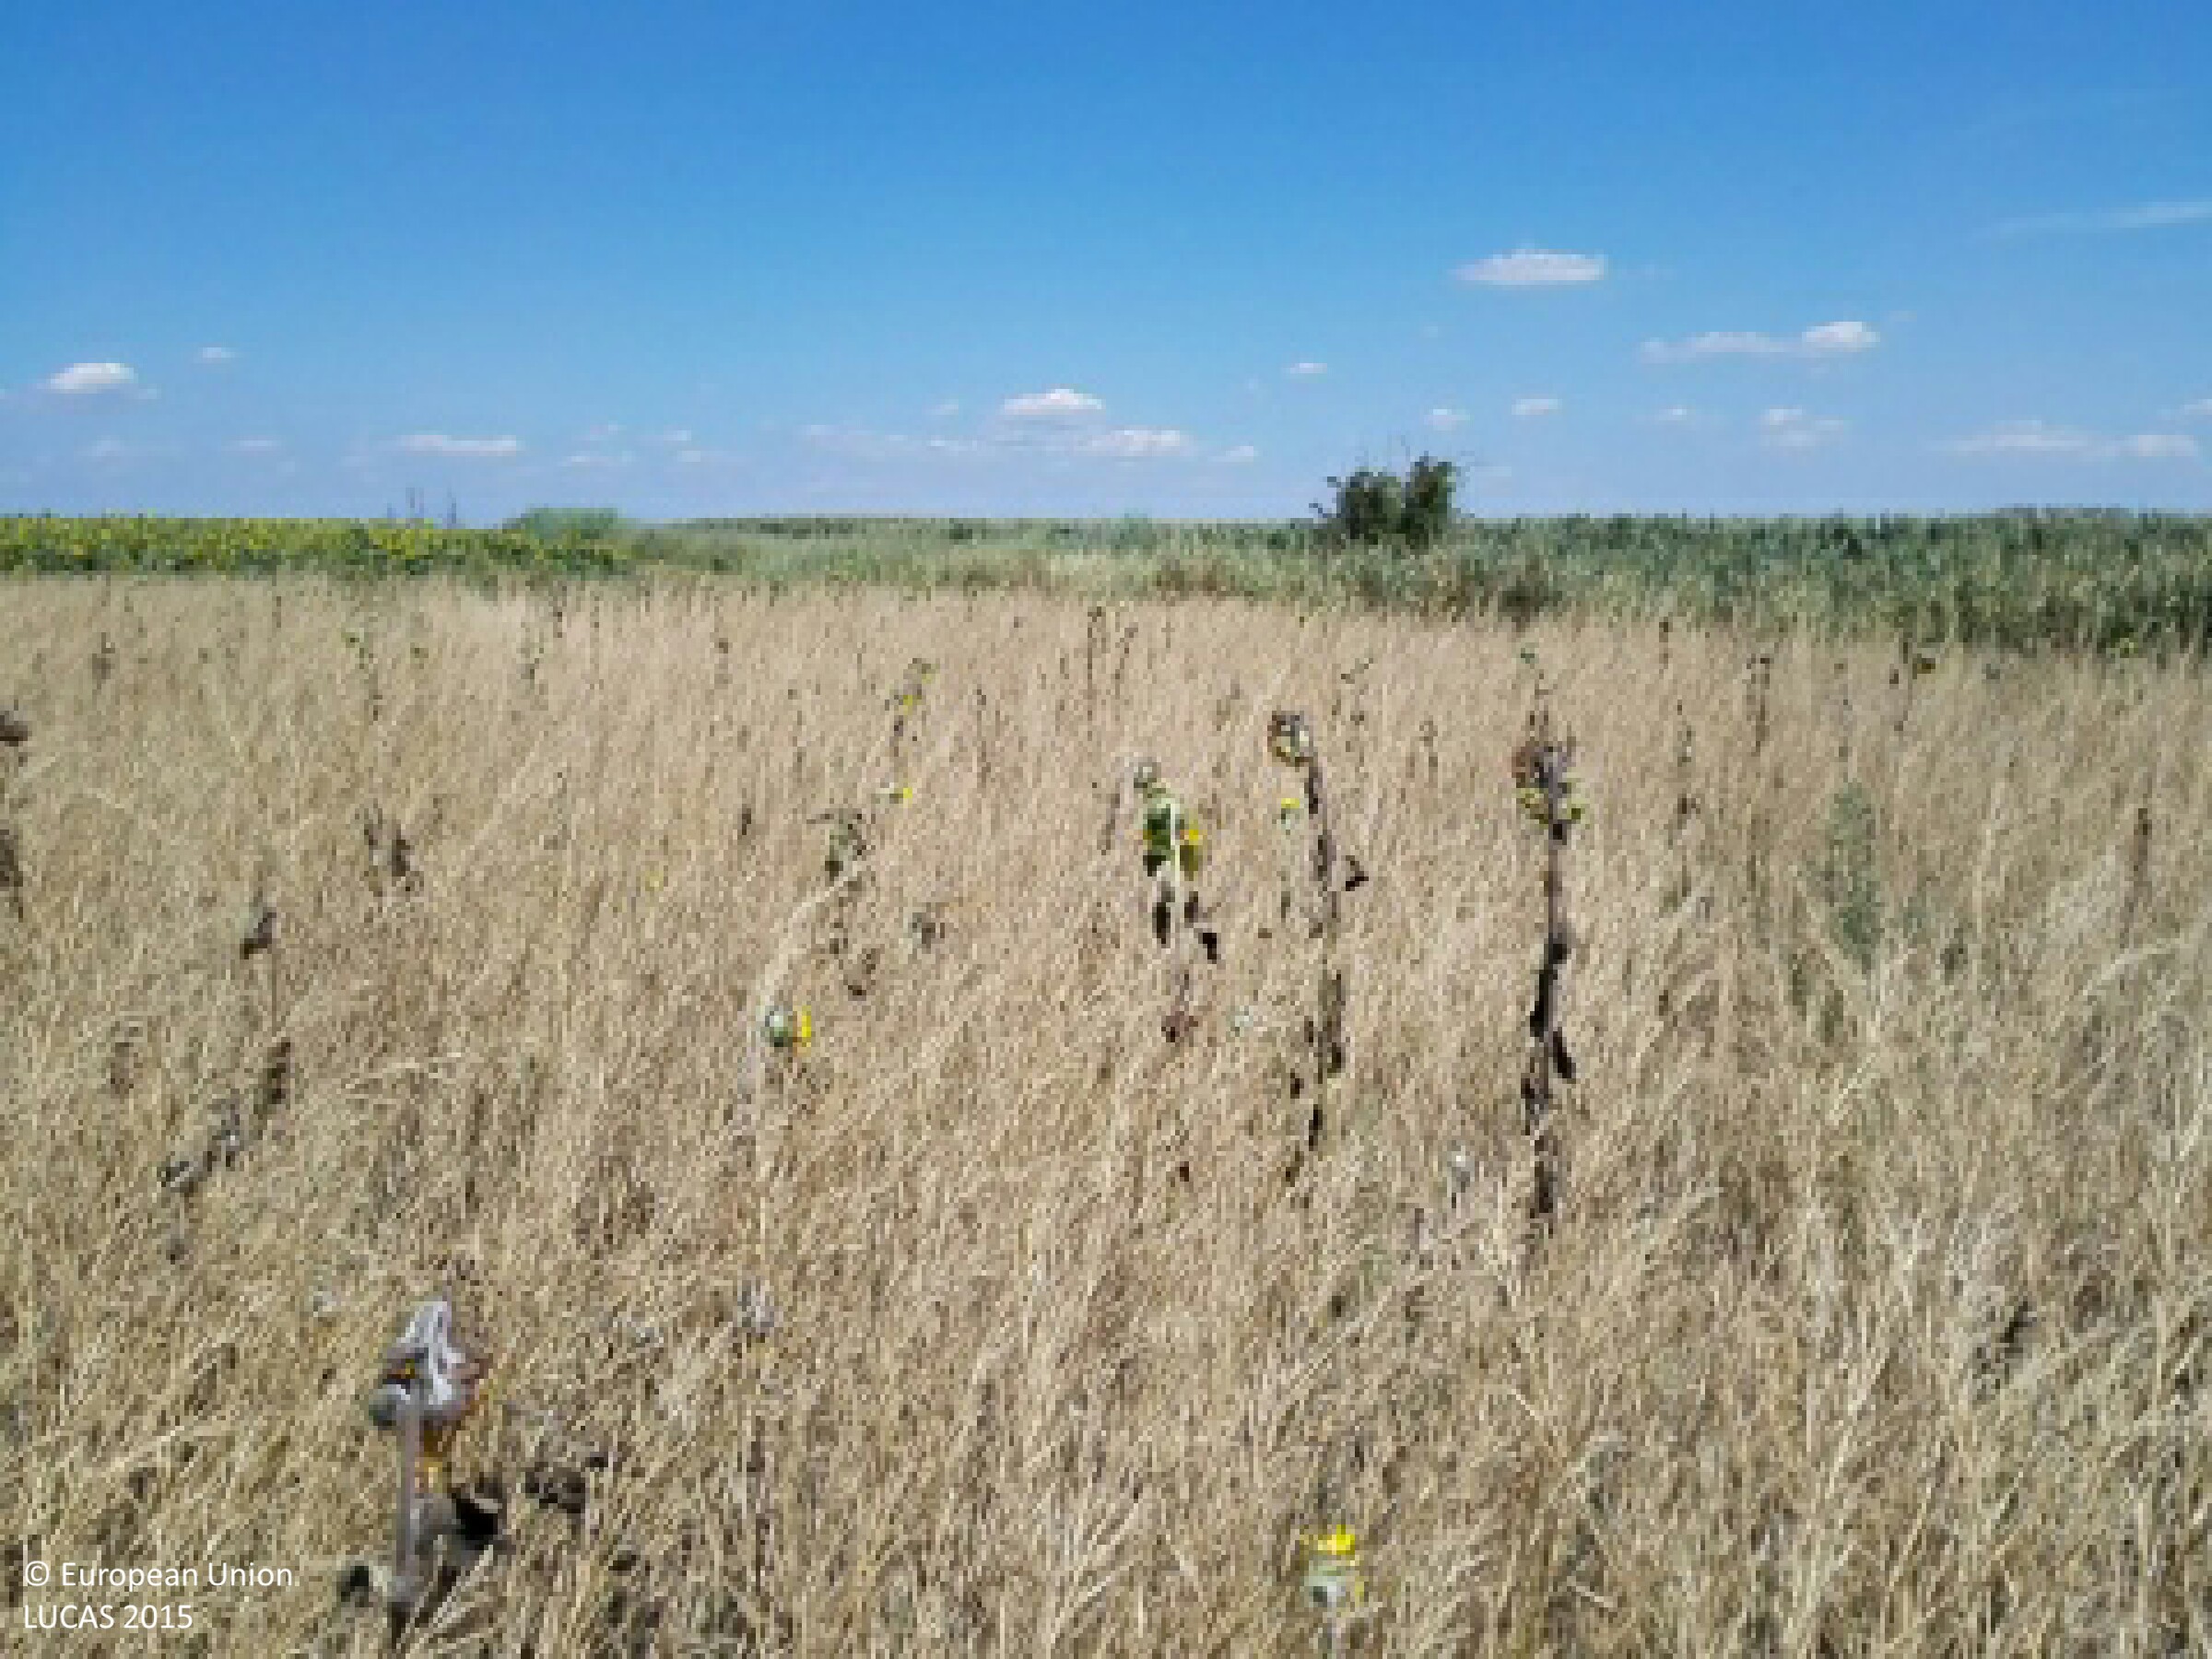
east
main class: Cropland
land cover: Rape and turnip rape
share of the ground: > 75 %
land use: Agriculture (excluding fallow land and kitchen gardens)
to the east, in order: Rape and turnip rape; Grass margins; Tracks; Grass margins; Ditches and canals; Grass margins; Tracks; Maize; Rape and turnip rape
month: July
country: HU
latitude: 47.3848
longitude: 21.3125
